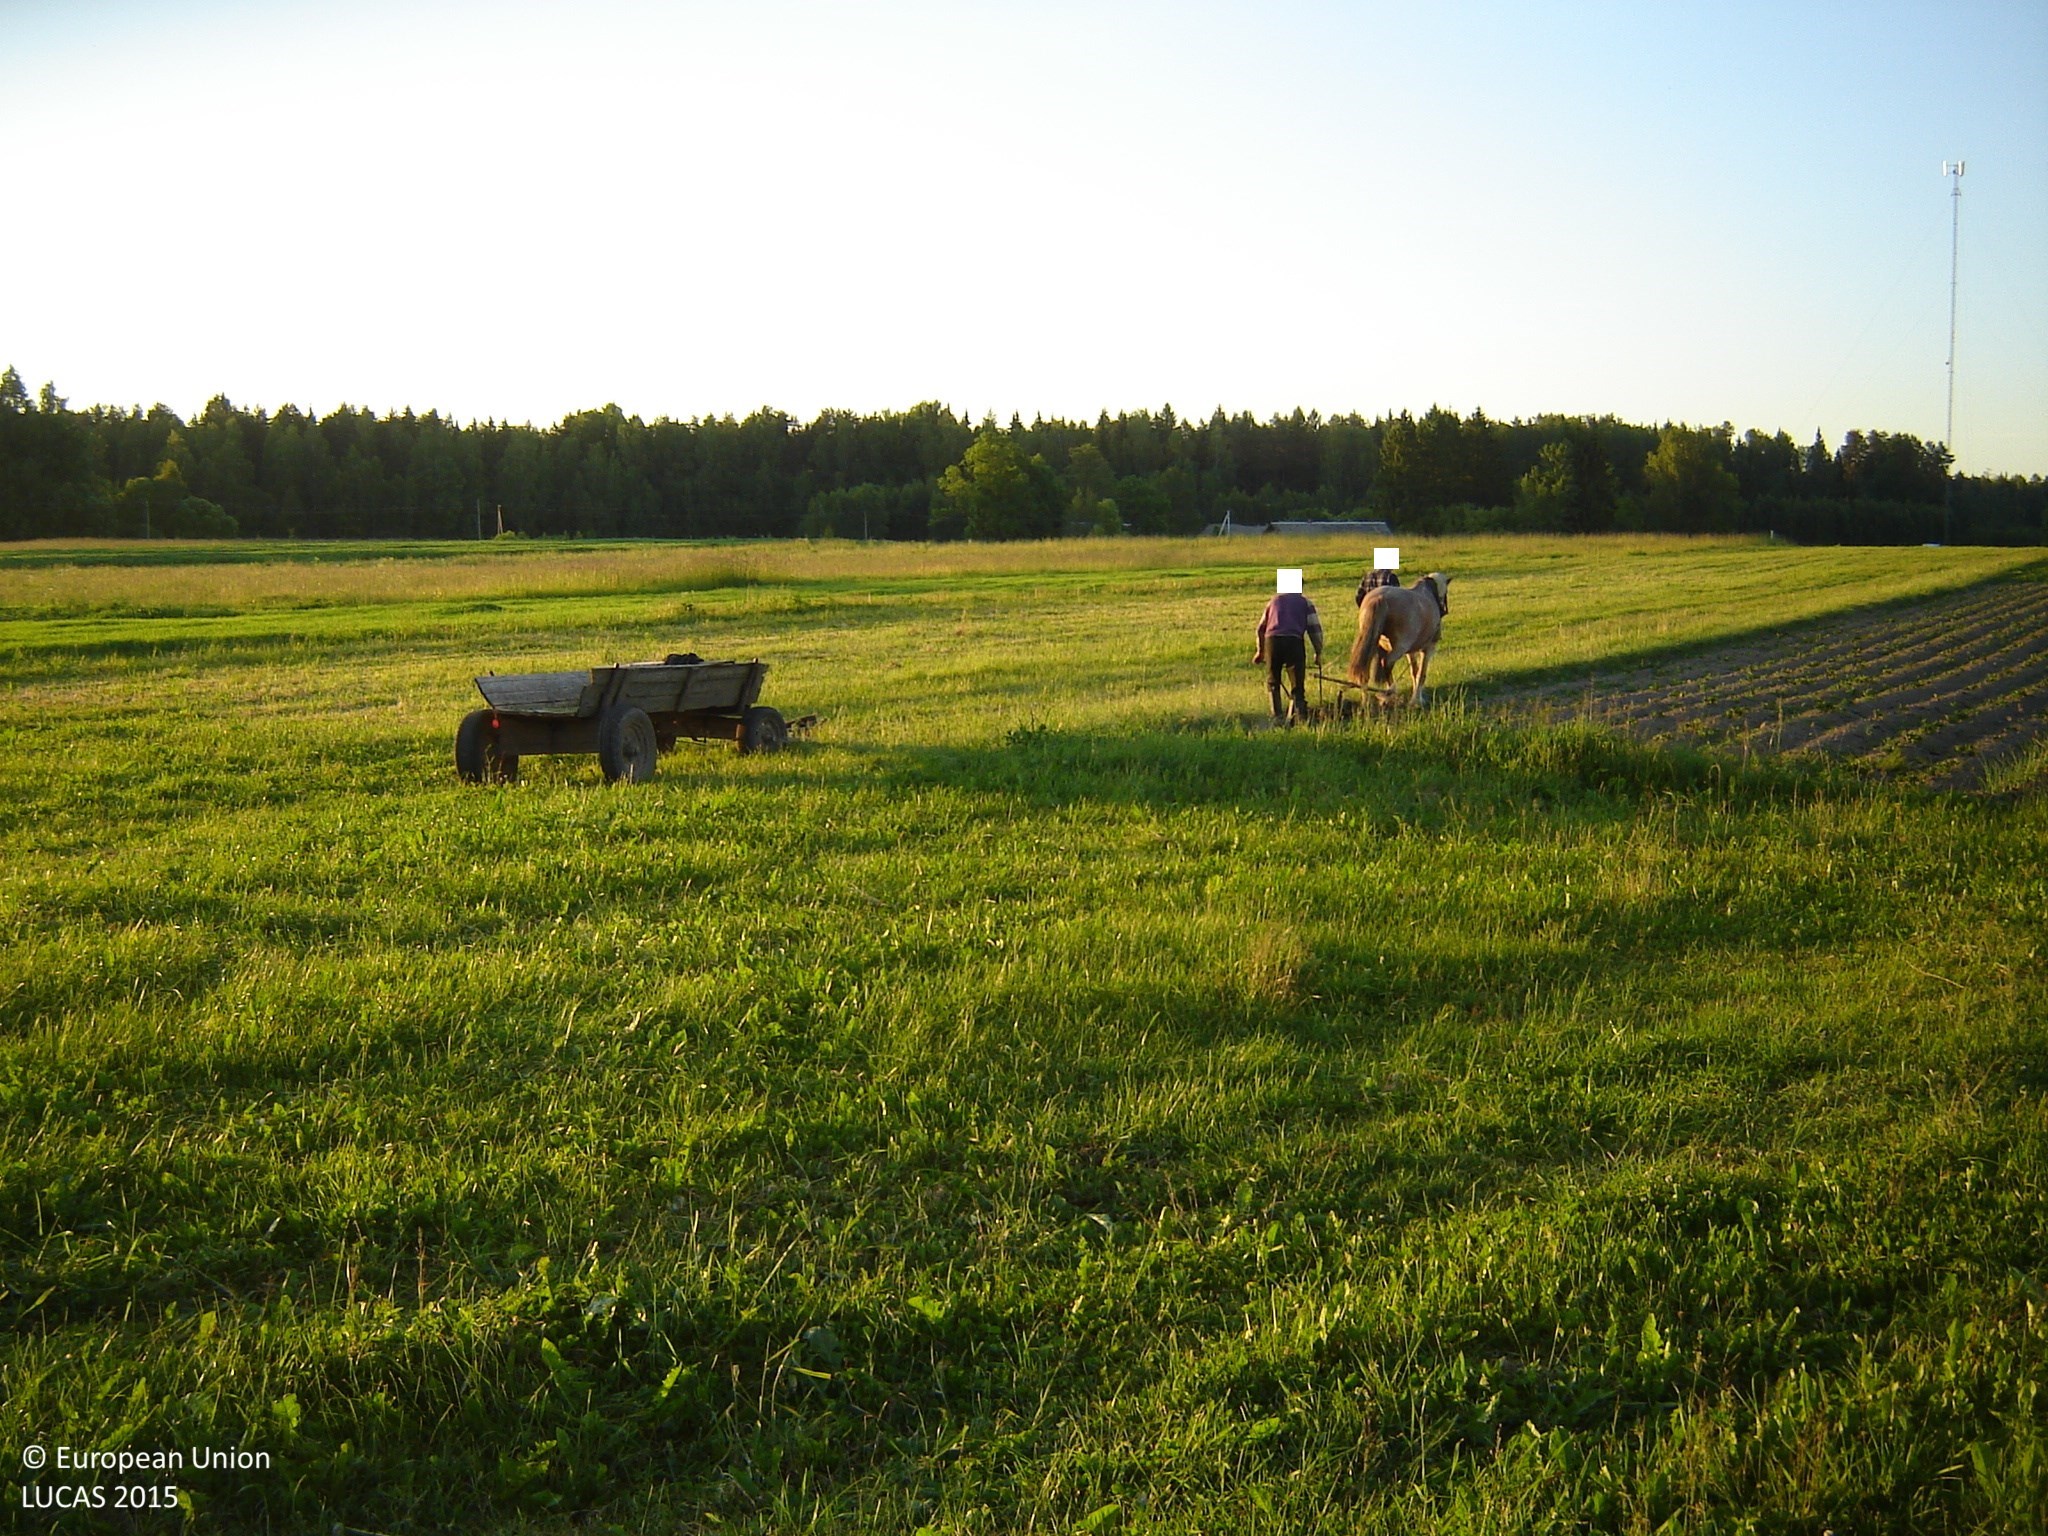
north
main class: Grassland
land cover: Grassland without tree/shrub cover
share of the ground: > 75 %
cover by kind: herbaceous plants 100 %
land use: Agriculture (excluding fallow land and kitchen gardens)
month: June
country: LT
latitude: 55.5819
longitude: 25.2354
